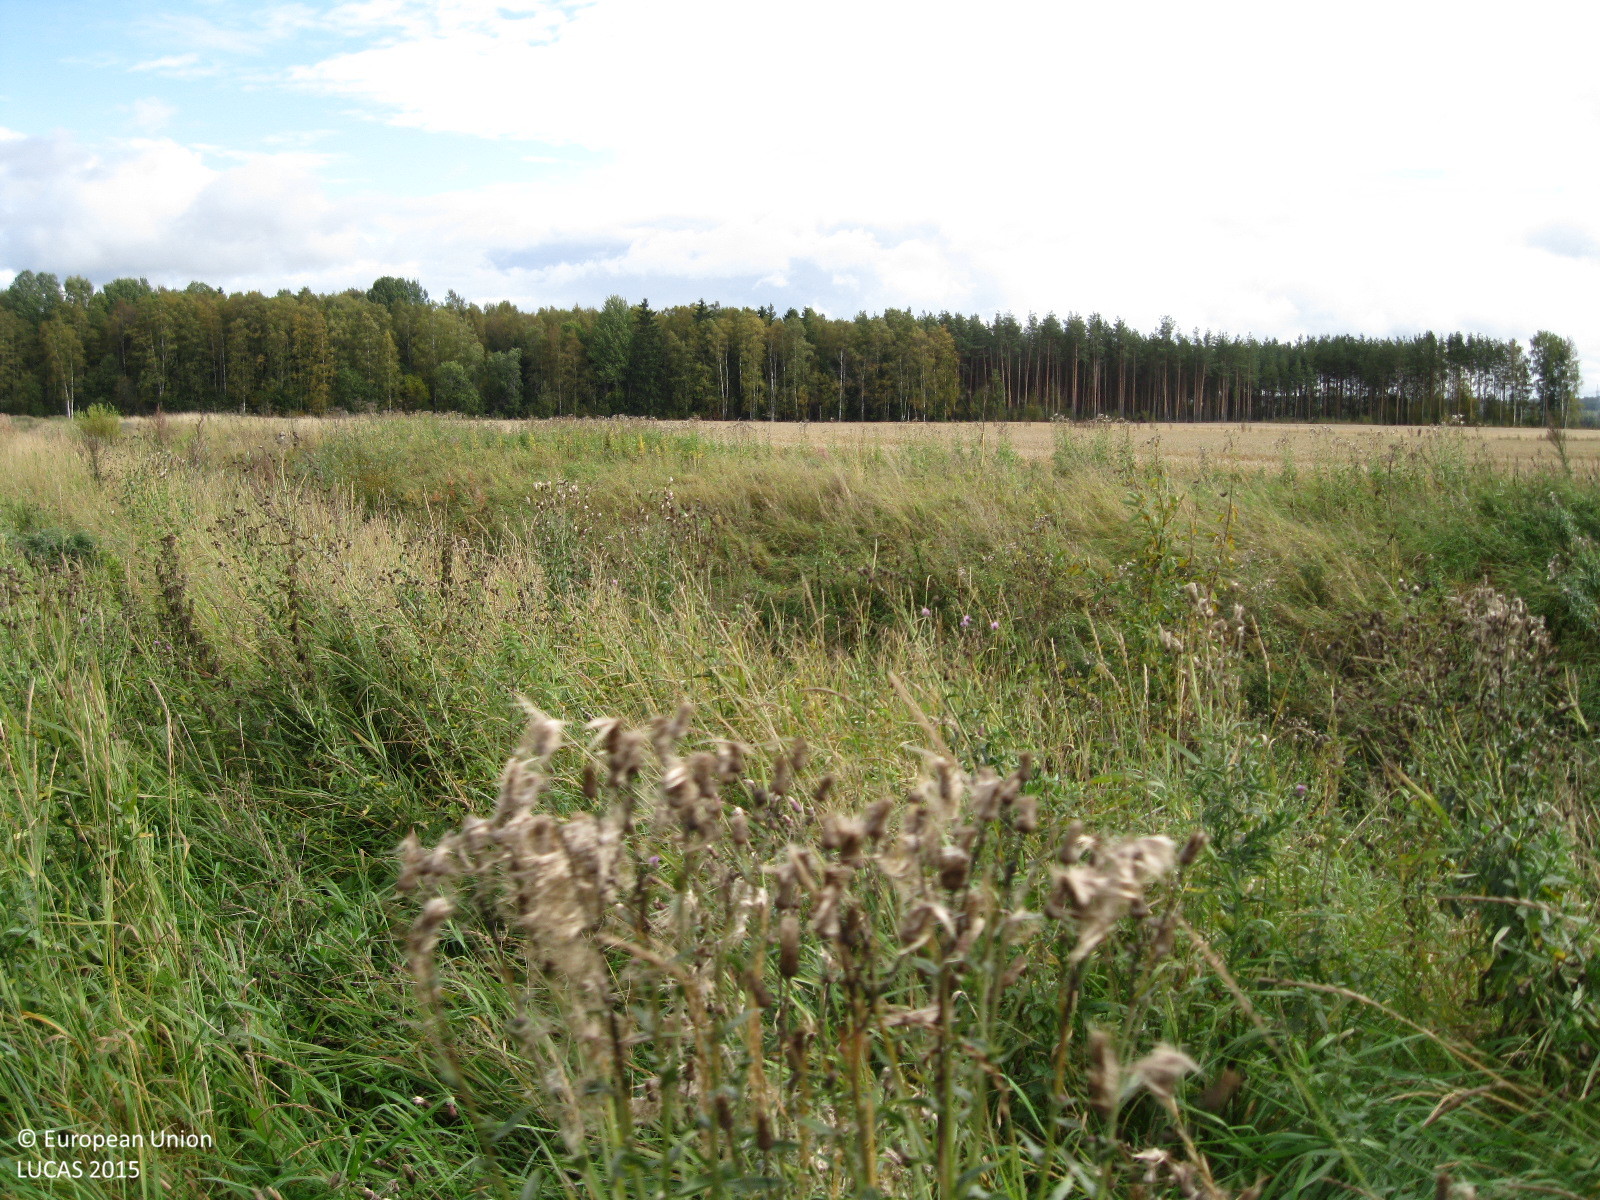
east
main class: Cropland
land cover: Barley
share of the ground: > 75 %
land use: Agriculture (excluding fallow land and kitchen gardens)
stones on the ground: < 10 %
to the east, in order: Barley; Spontaneously vegetated surfaces; Ditches and canals; Spontaneously vegetated surfaces; Common wheat; Spontaneously vegetated surfaces; Ditches and canals; Spontaneously vegetated surfaces; Barley
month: September
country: FI
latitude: 60.7772
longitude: 24.7444
